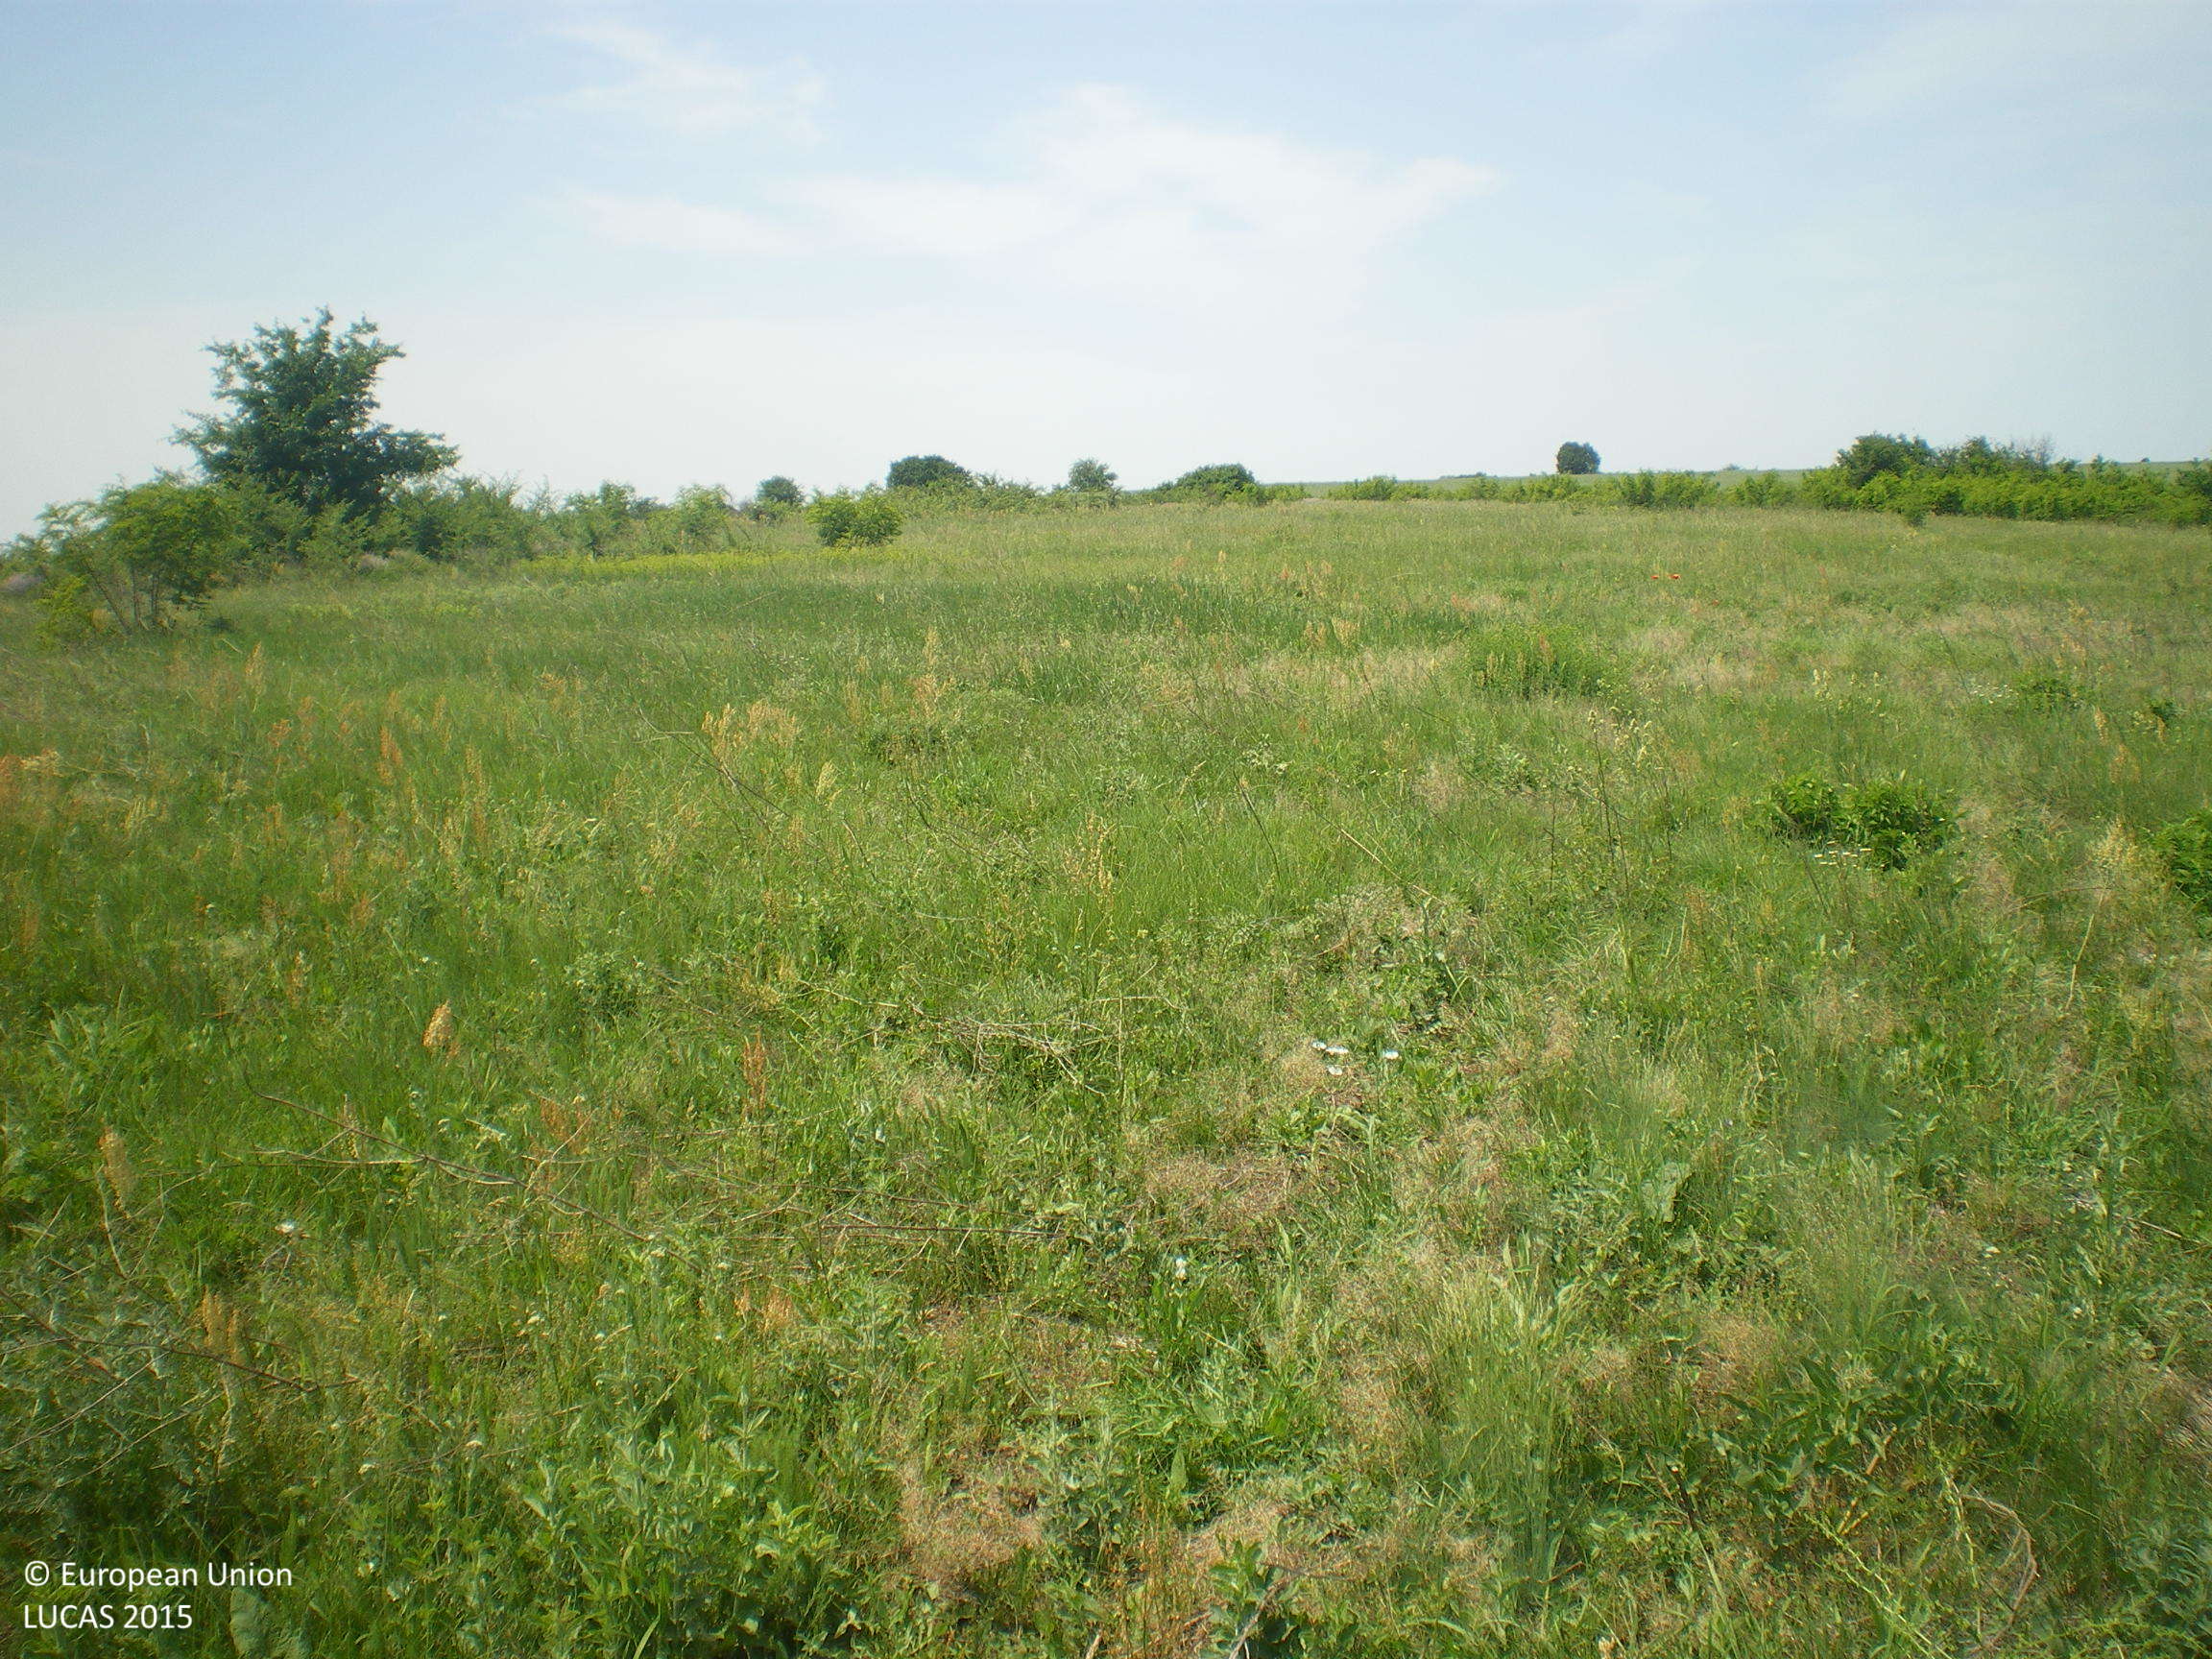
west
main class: Grassland
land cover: Spontaneously vegetated surfaces
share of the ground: > 75 %
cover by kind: herbaceous plants 100 %
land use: Semi-natural and natural areas not in use
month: May
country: BG
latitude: 42.1198
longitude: 25.3389
